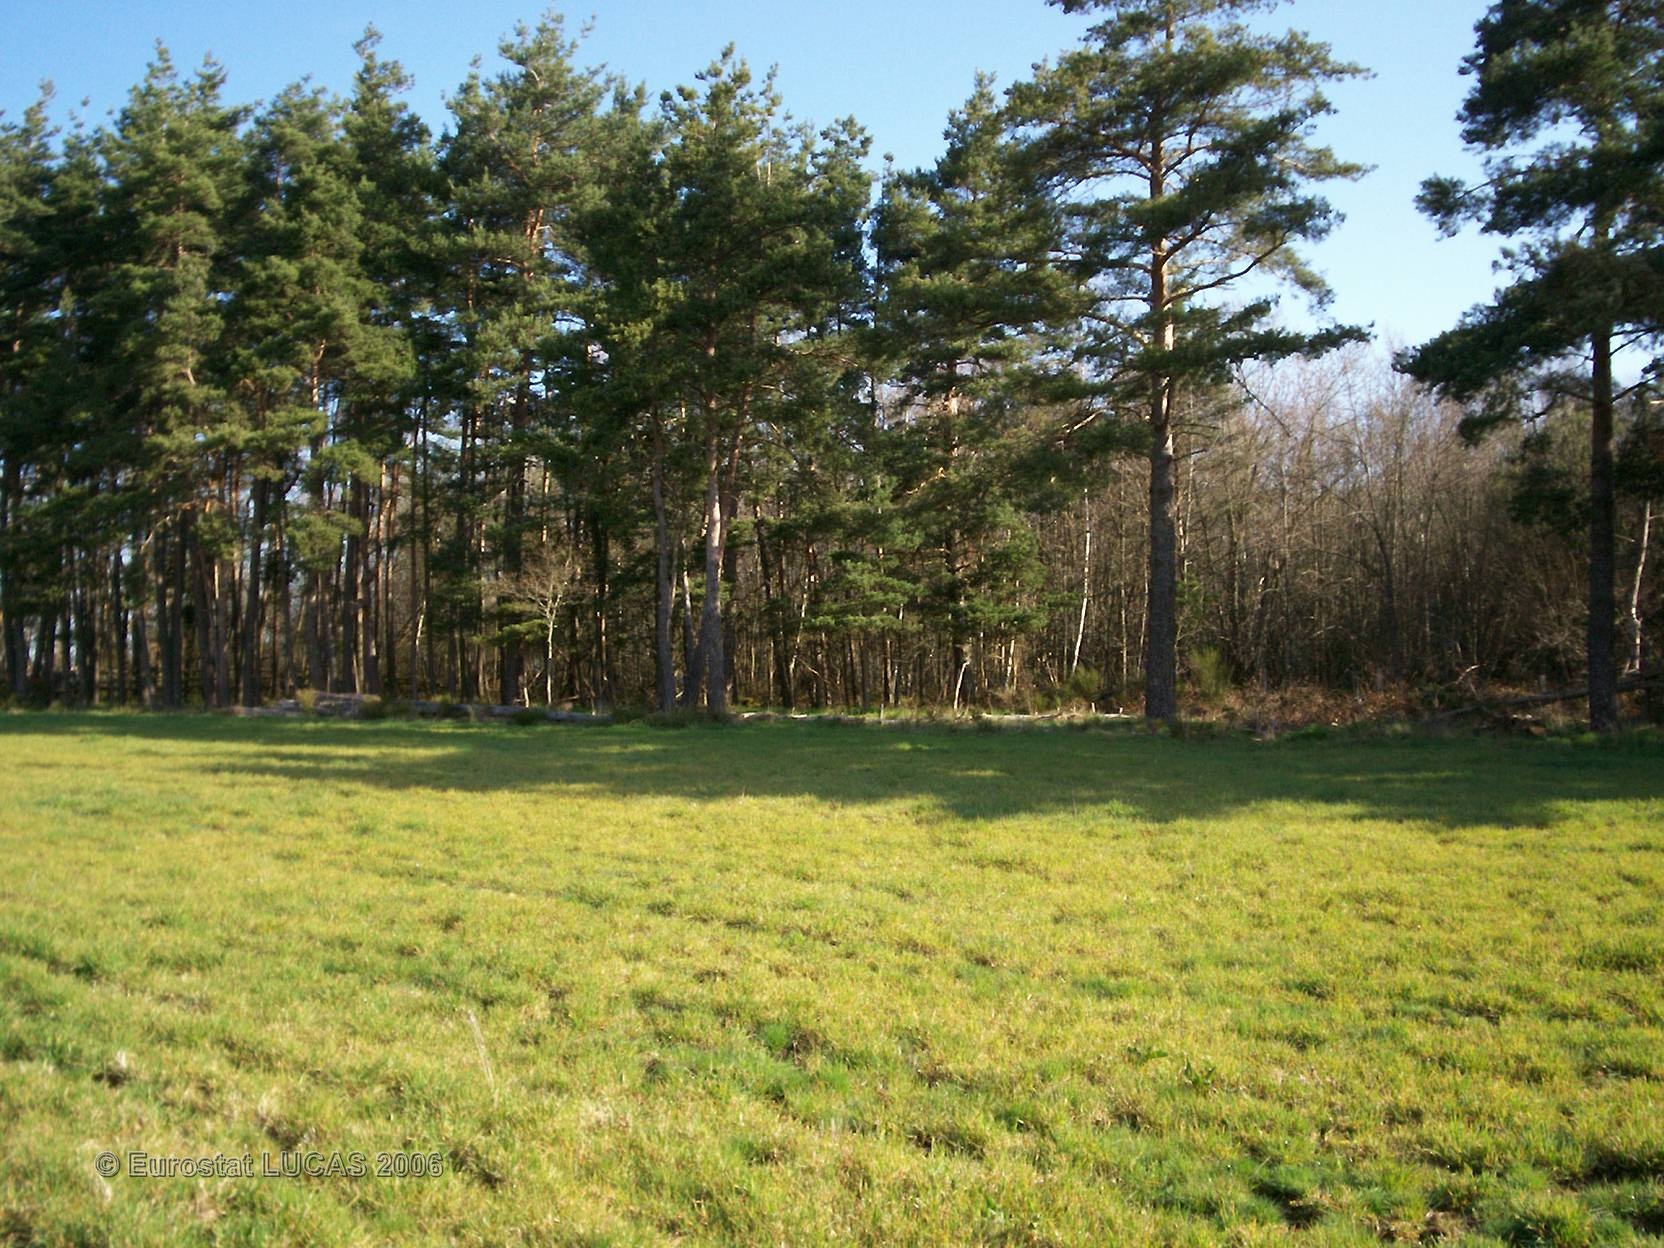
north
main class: Grassland
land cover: Grassland without tree/shrub cover
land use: Agriculture (excluding fallow land and kitchen gardens)
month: April
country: FR
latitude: 44.9935
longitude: 3.1657
